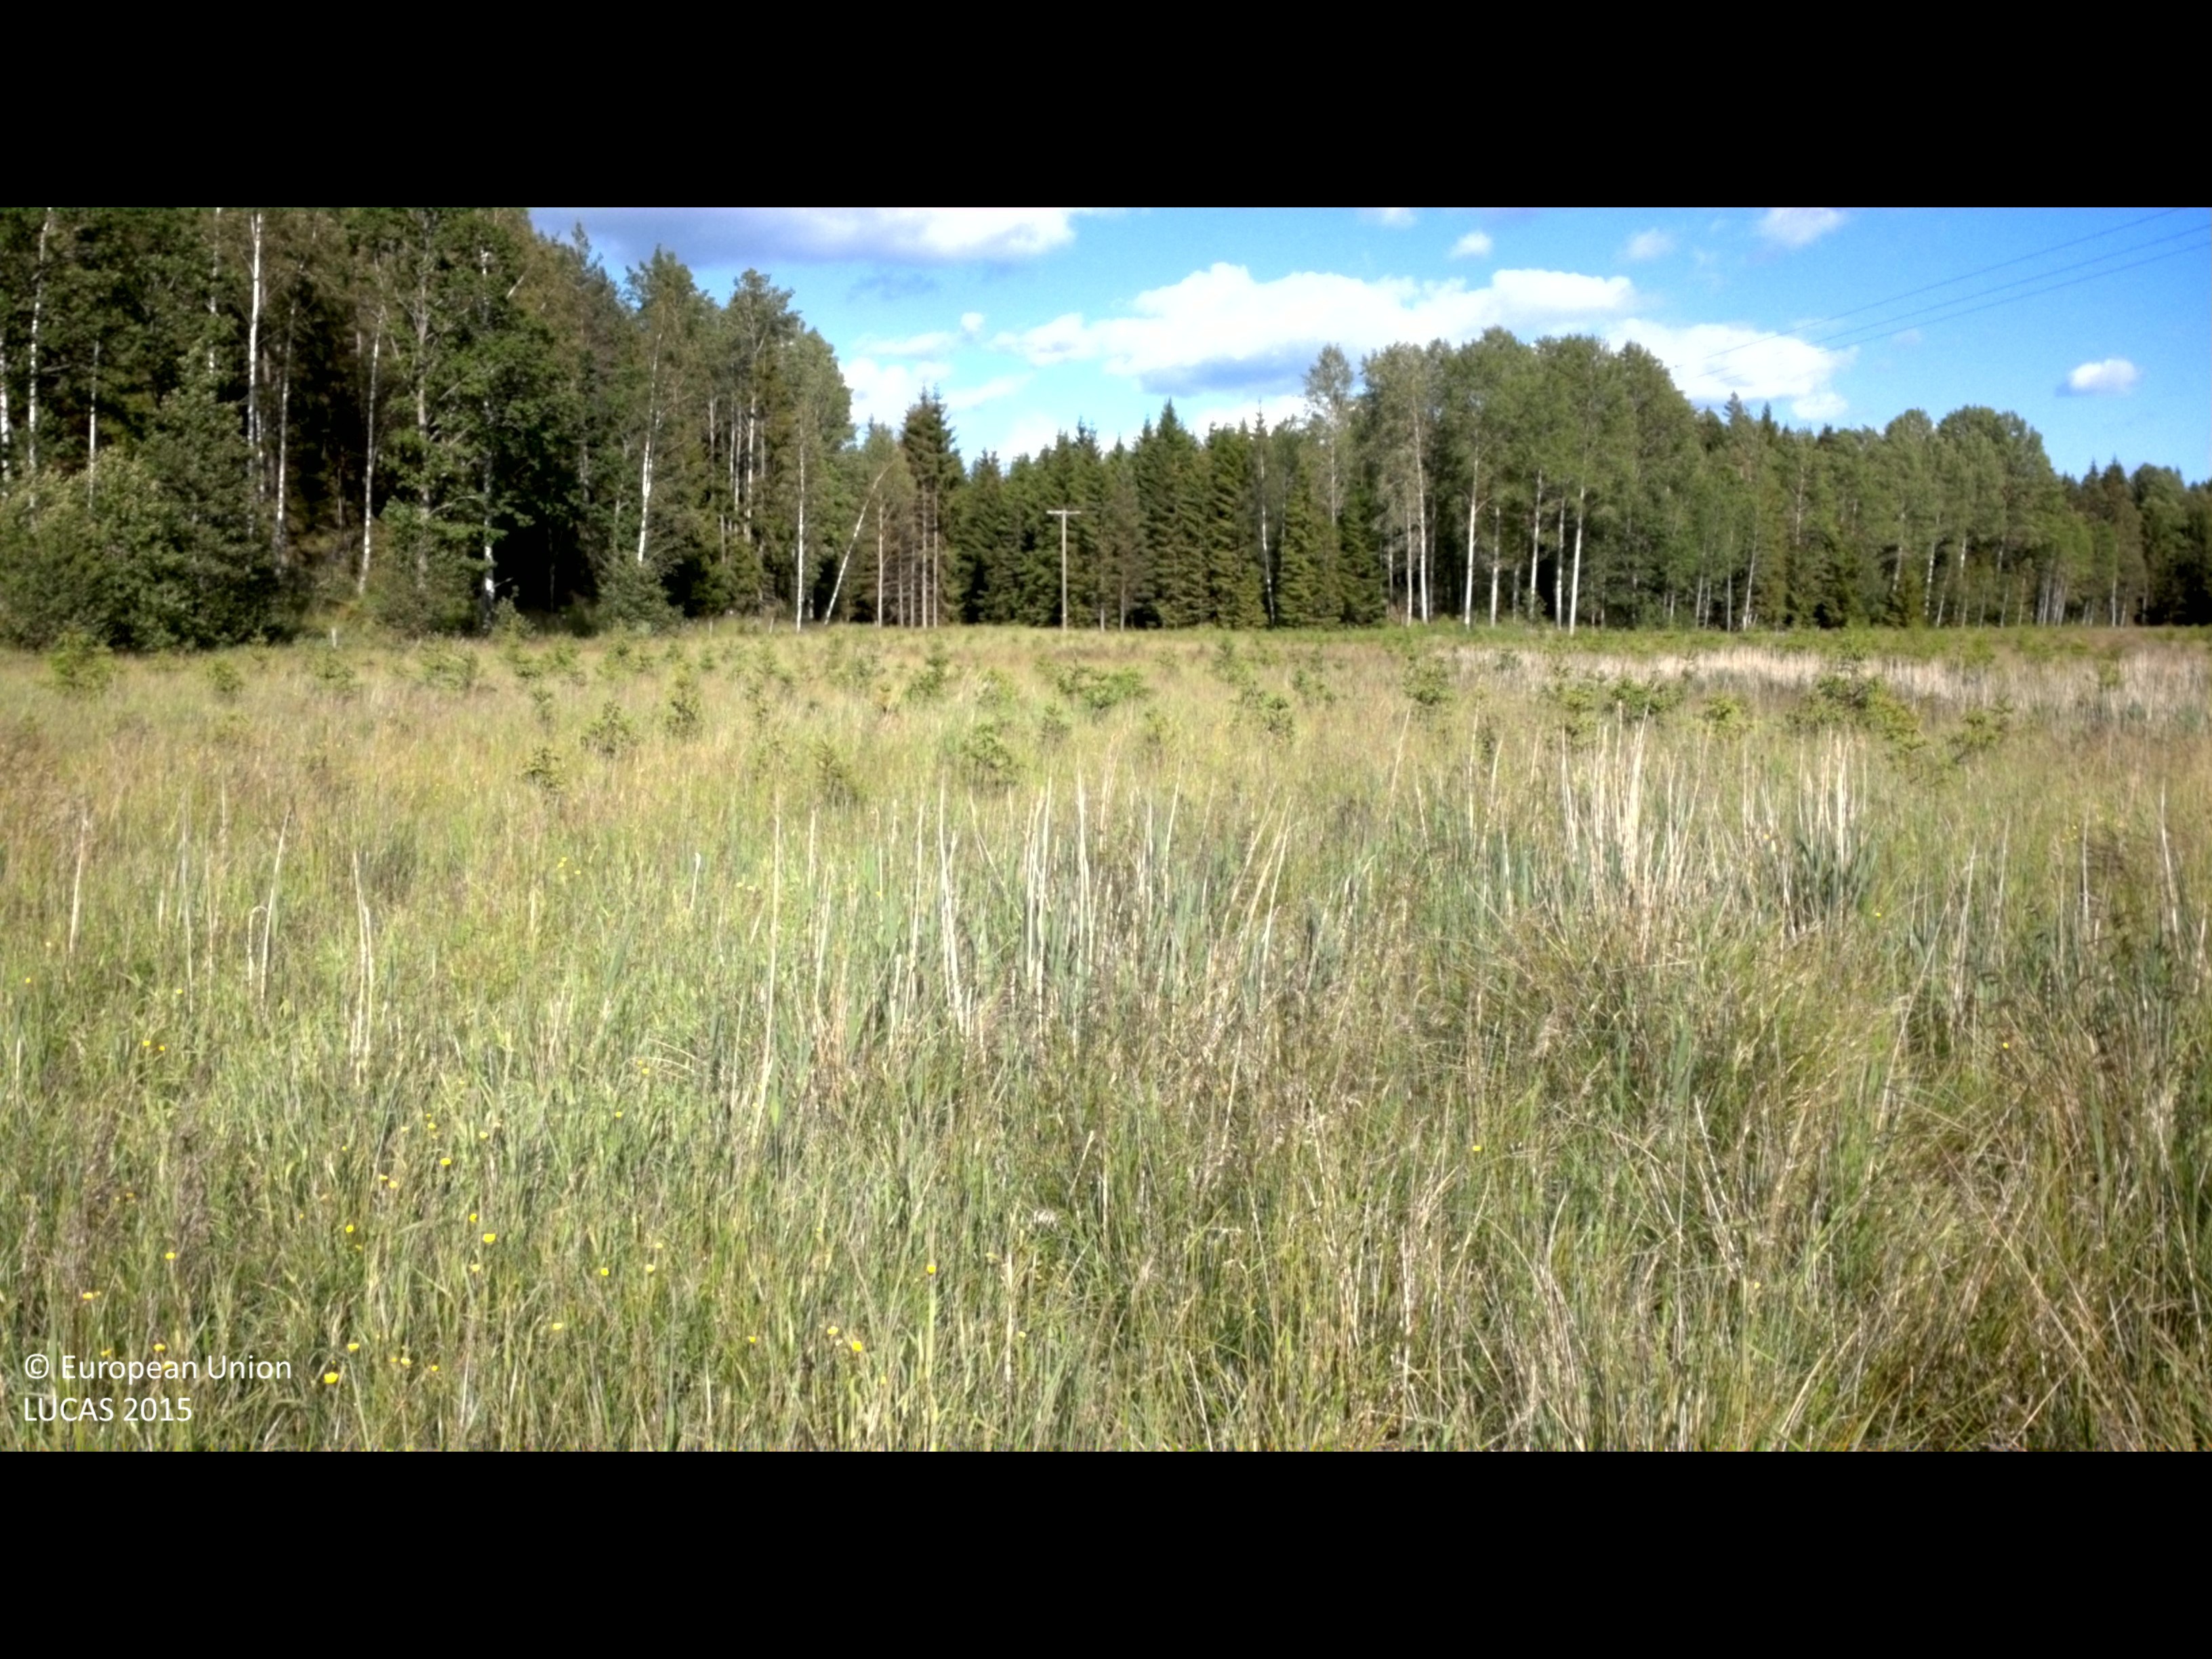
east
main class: Woodland
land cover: Spruce dominated coniferous woodland
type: boreal forest
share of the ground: < 10 %
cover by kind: herbaceous plants 90 %, coniferous forest trees 10 %
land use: Forestry
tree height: < 5 m
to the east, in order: Spruce dominated coniferous woodland; Grassland with sparse tree/shrub cover; Spruce dominated coniferous woodland; Electric lines; Spruce dominated coniferous woodland; Grassland with sparse tree/shrub cover; Ditches and canals; Spruce dominated coniferous woodland; Spruce dominated mixed woodland; Other coniferous woodland
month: June
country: SE
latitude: 58.0936
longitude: 16.5965
